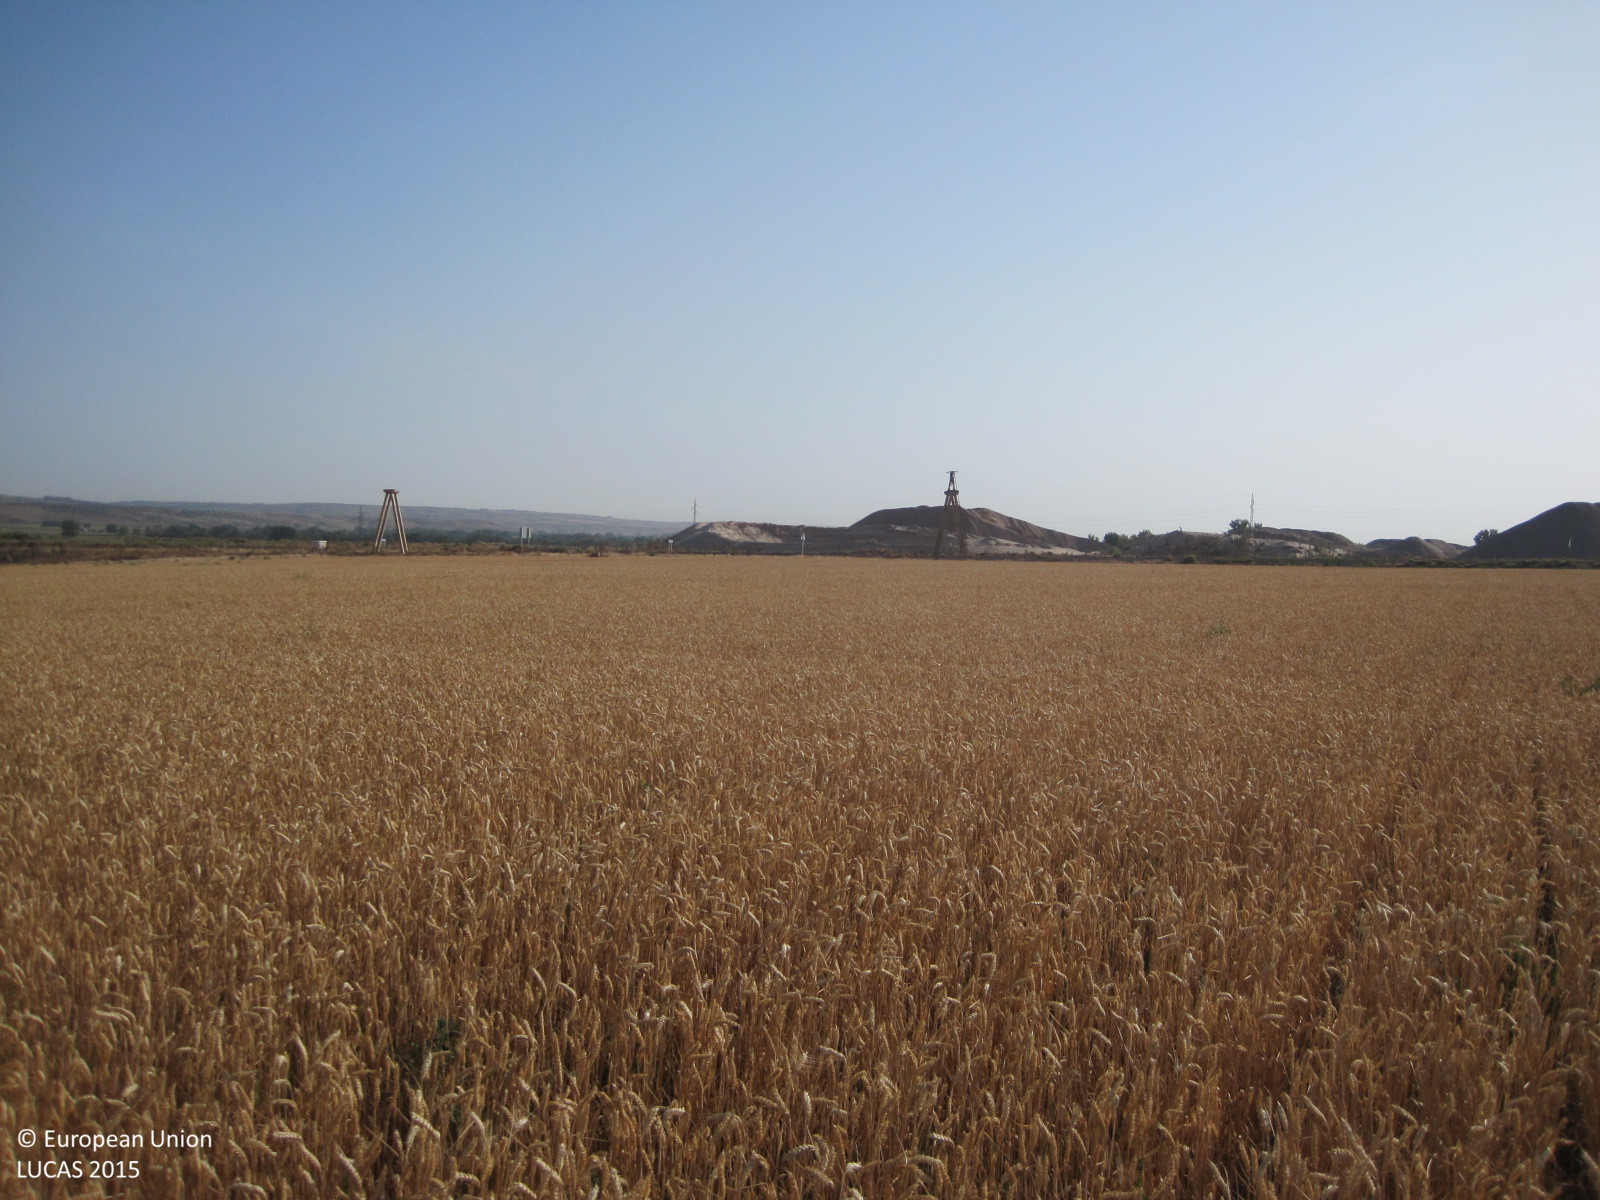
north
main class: Cropland
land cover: Common wheat
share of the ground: > 75 %
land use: Agriculture (excluding fallow land and kitchen gardens)
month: July
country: ES
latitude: 39.9553
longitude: -3.7392
